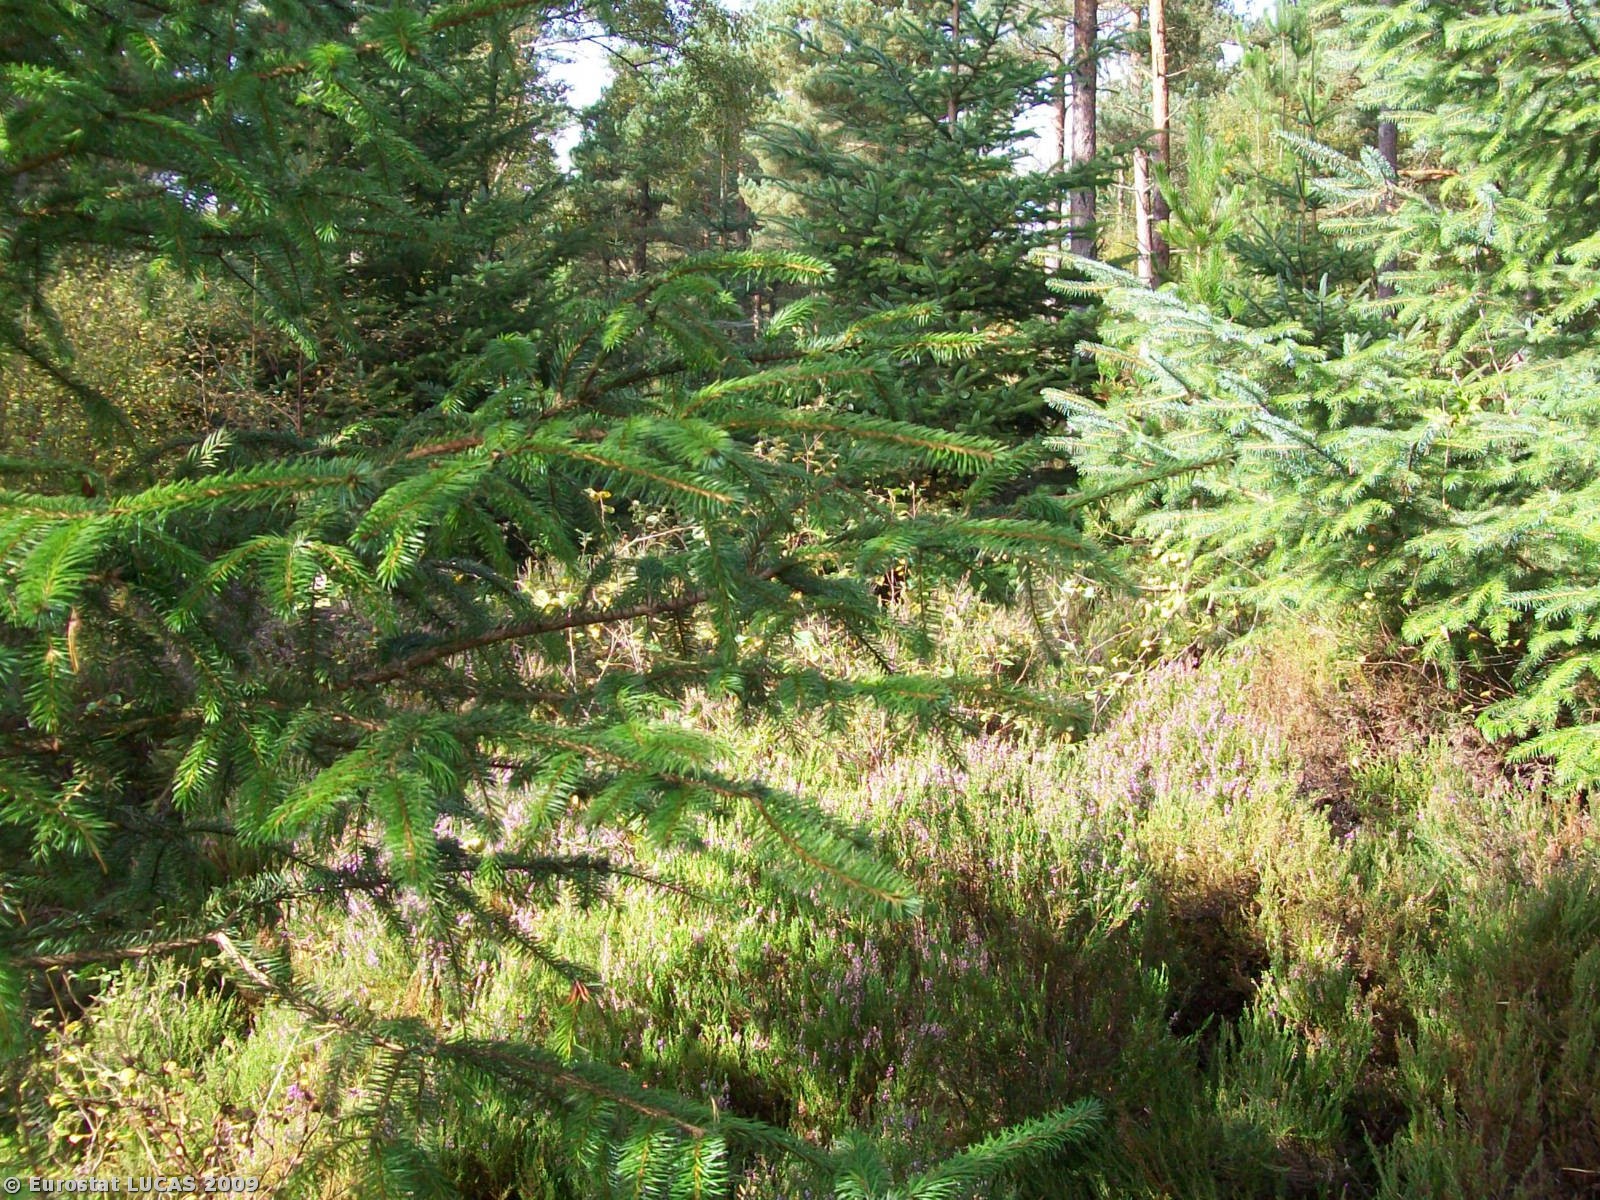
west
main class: Woodland
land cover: Coniferous woodland
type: plantations and self-sown exotic forest
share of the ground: 50 - 75 %
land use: Forestry
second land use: Forestry
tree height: > 5 m
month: September
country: GB
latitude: 57.2854
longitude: -2.5130
